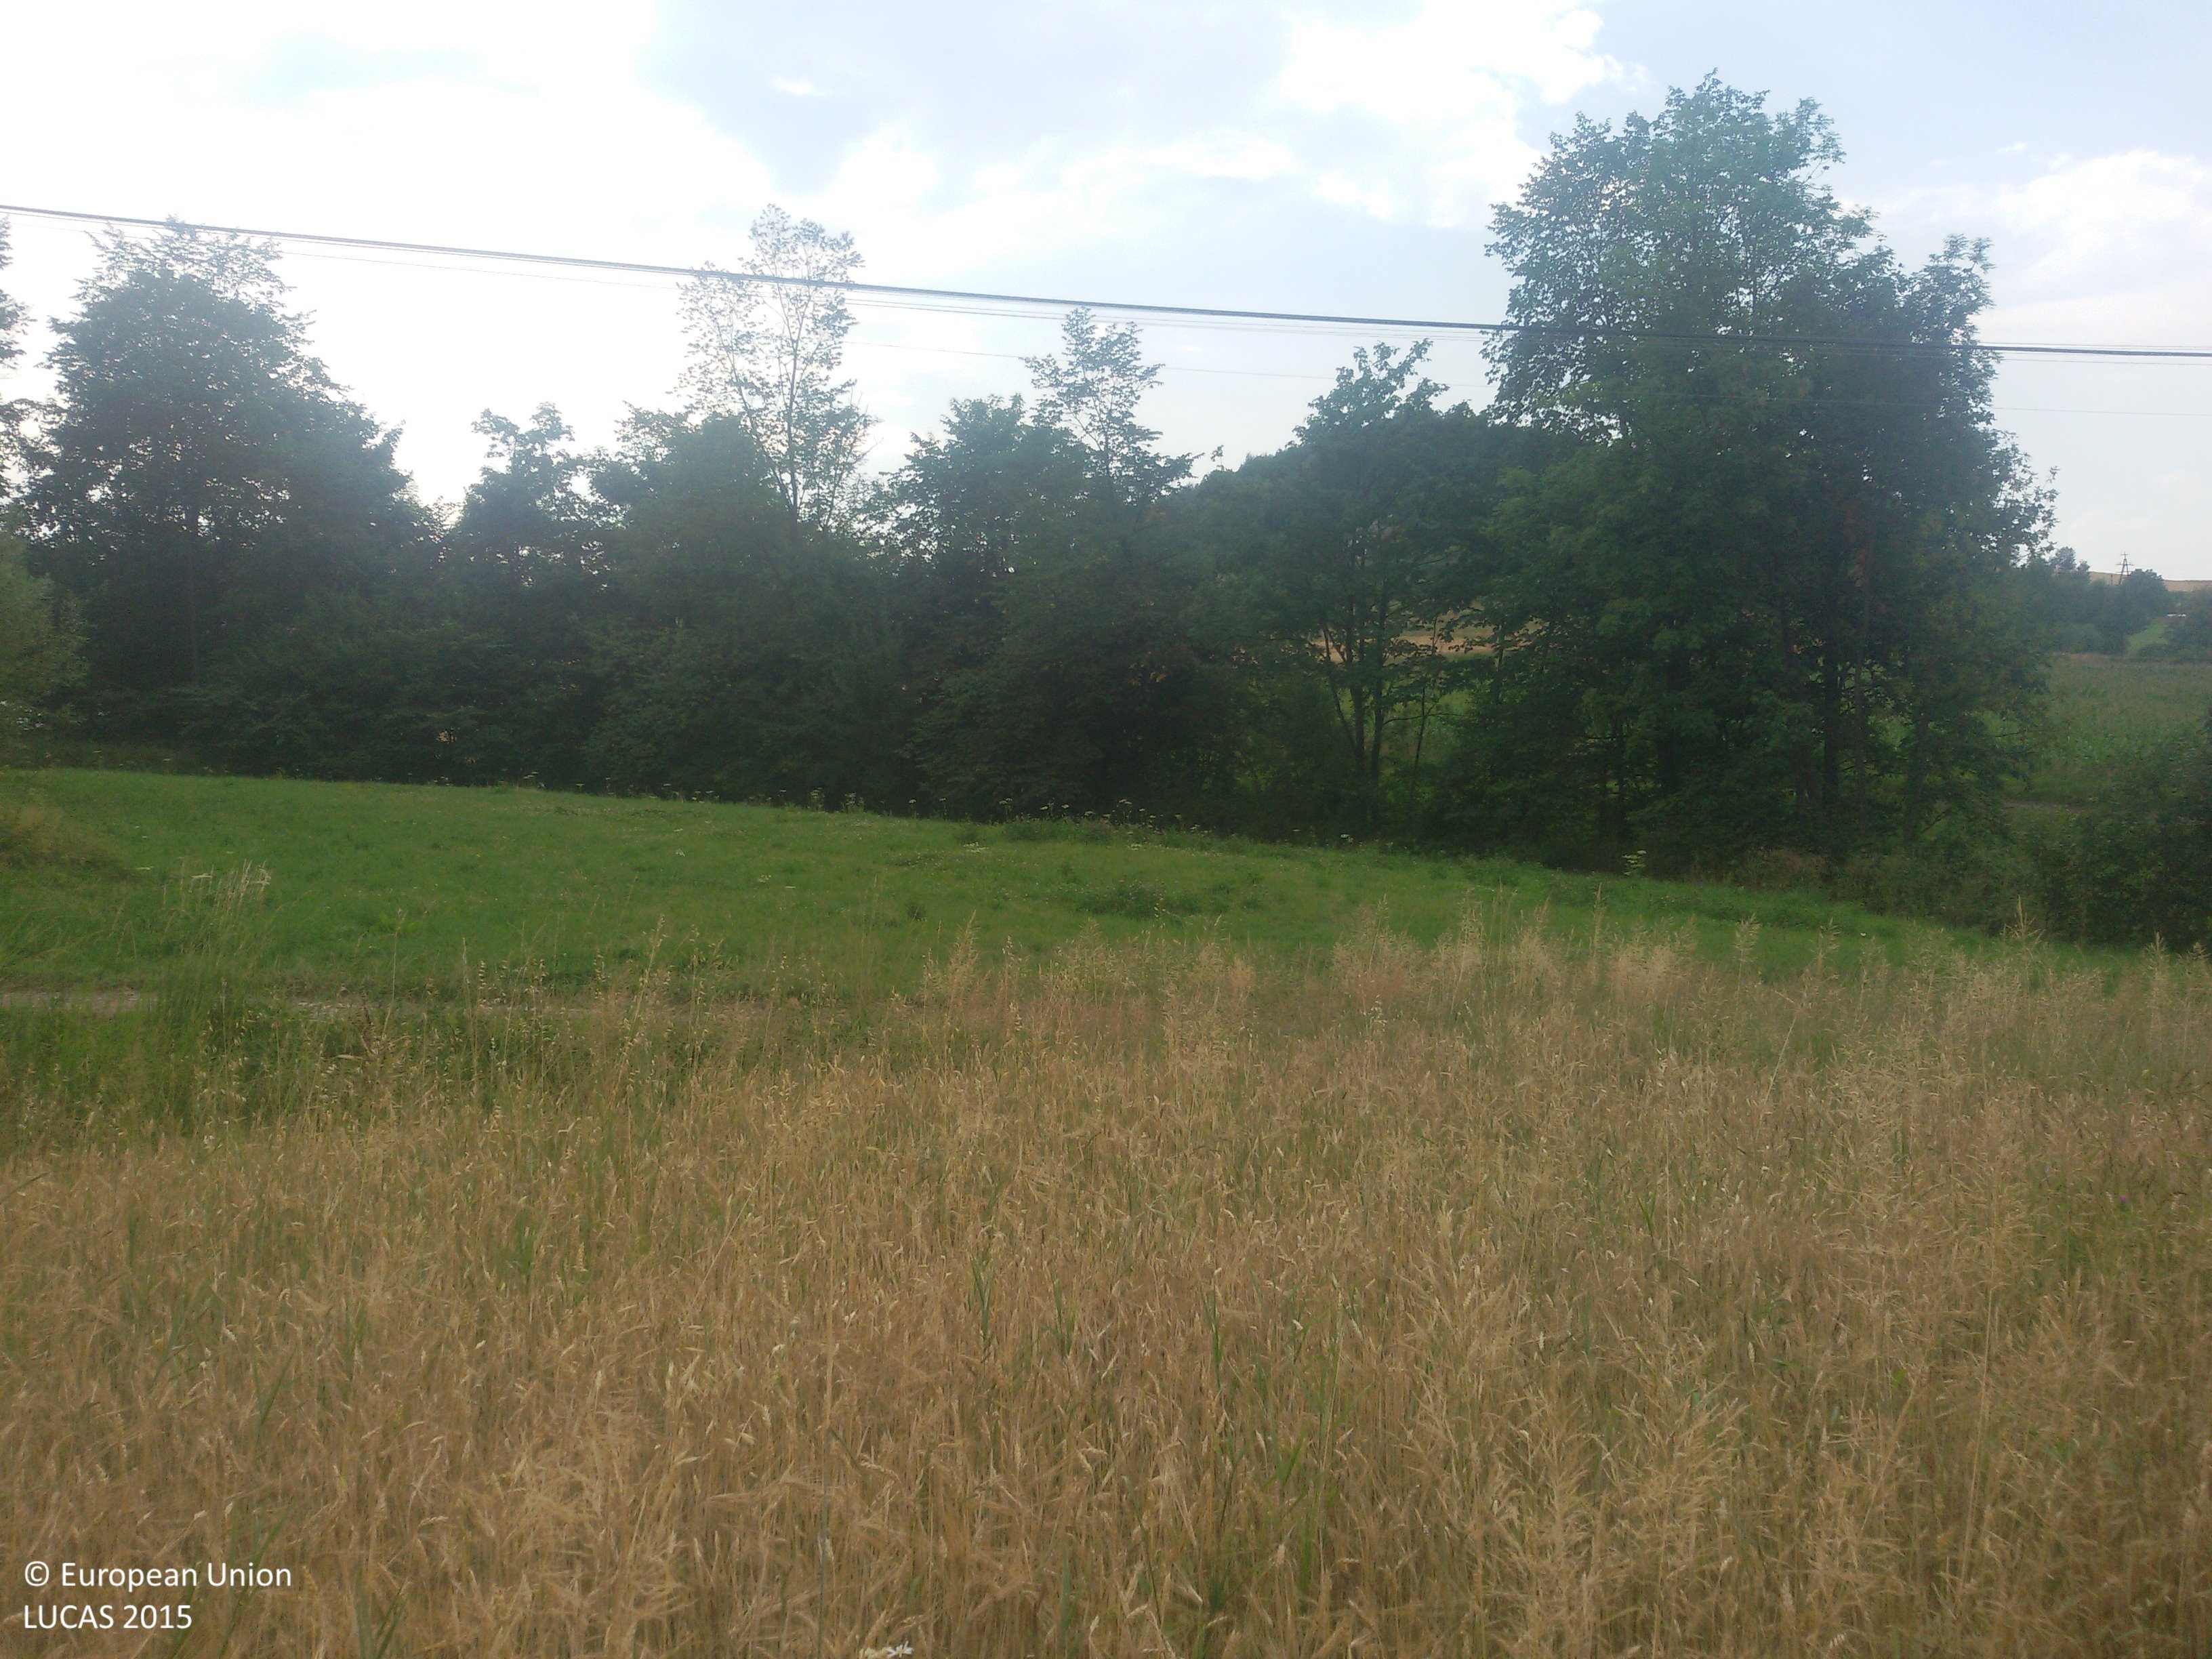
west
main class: Cropland
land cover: Mixed cereals for fodder
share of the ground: > 75 %
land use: Agriculture (excluding fallow land and kitchen gardens)
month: August
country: PL
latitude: 49.7457
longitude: 20.1784
